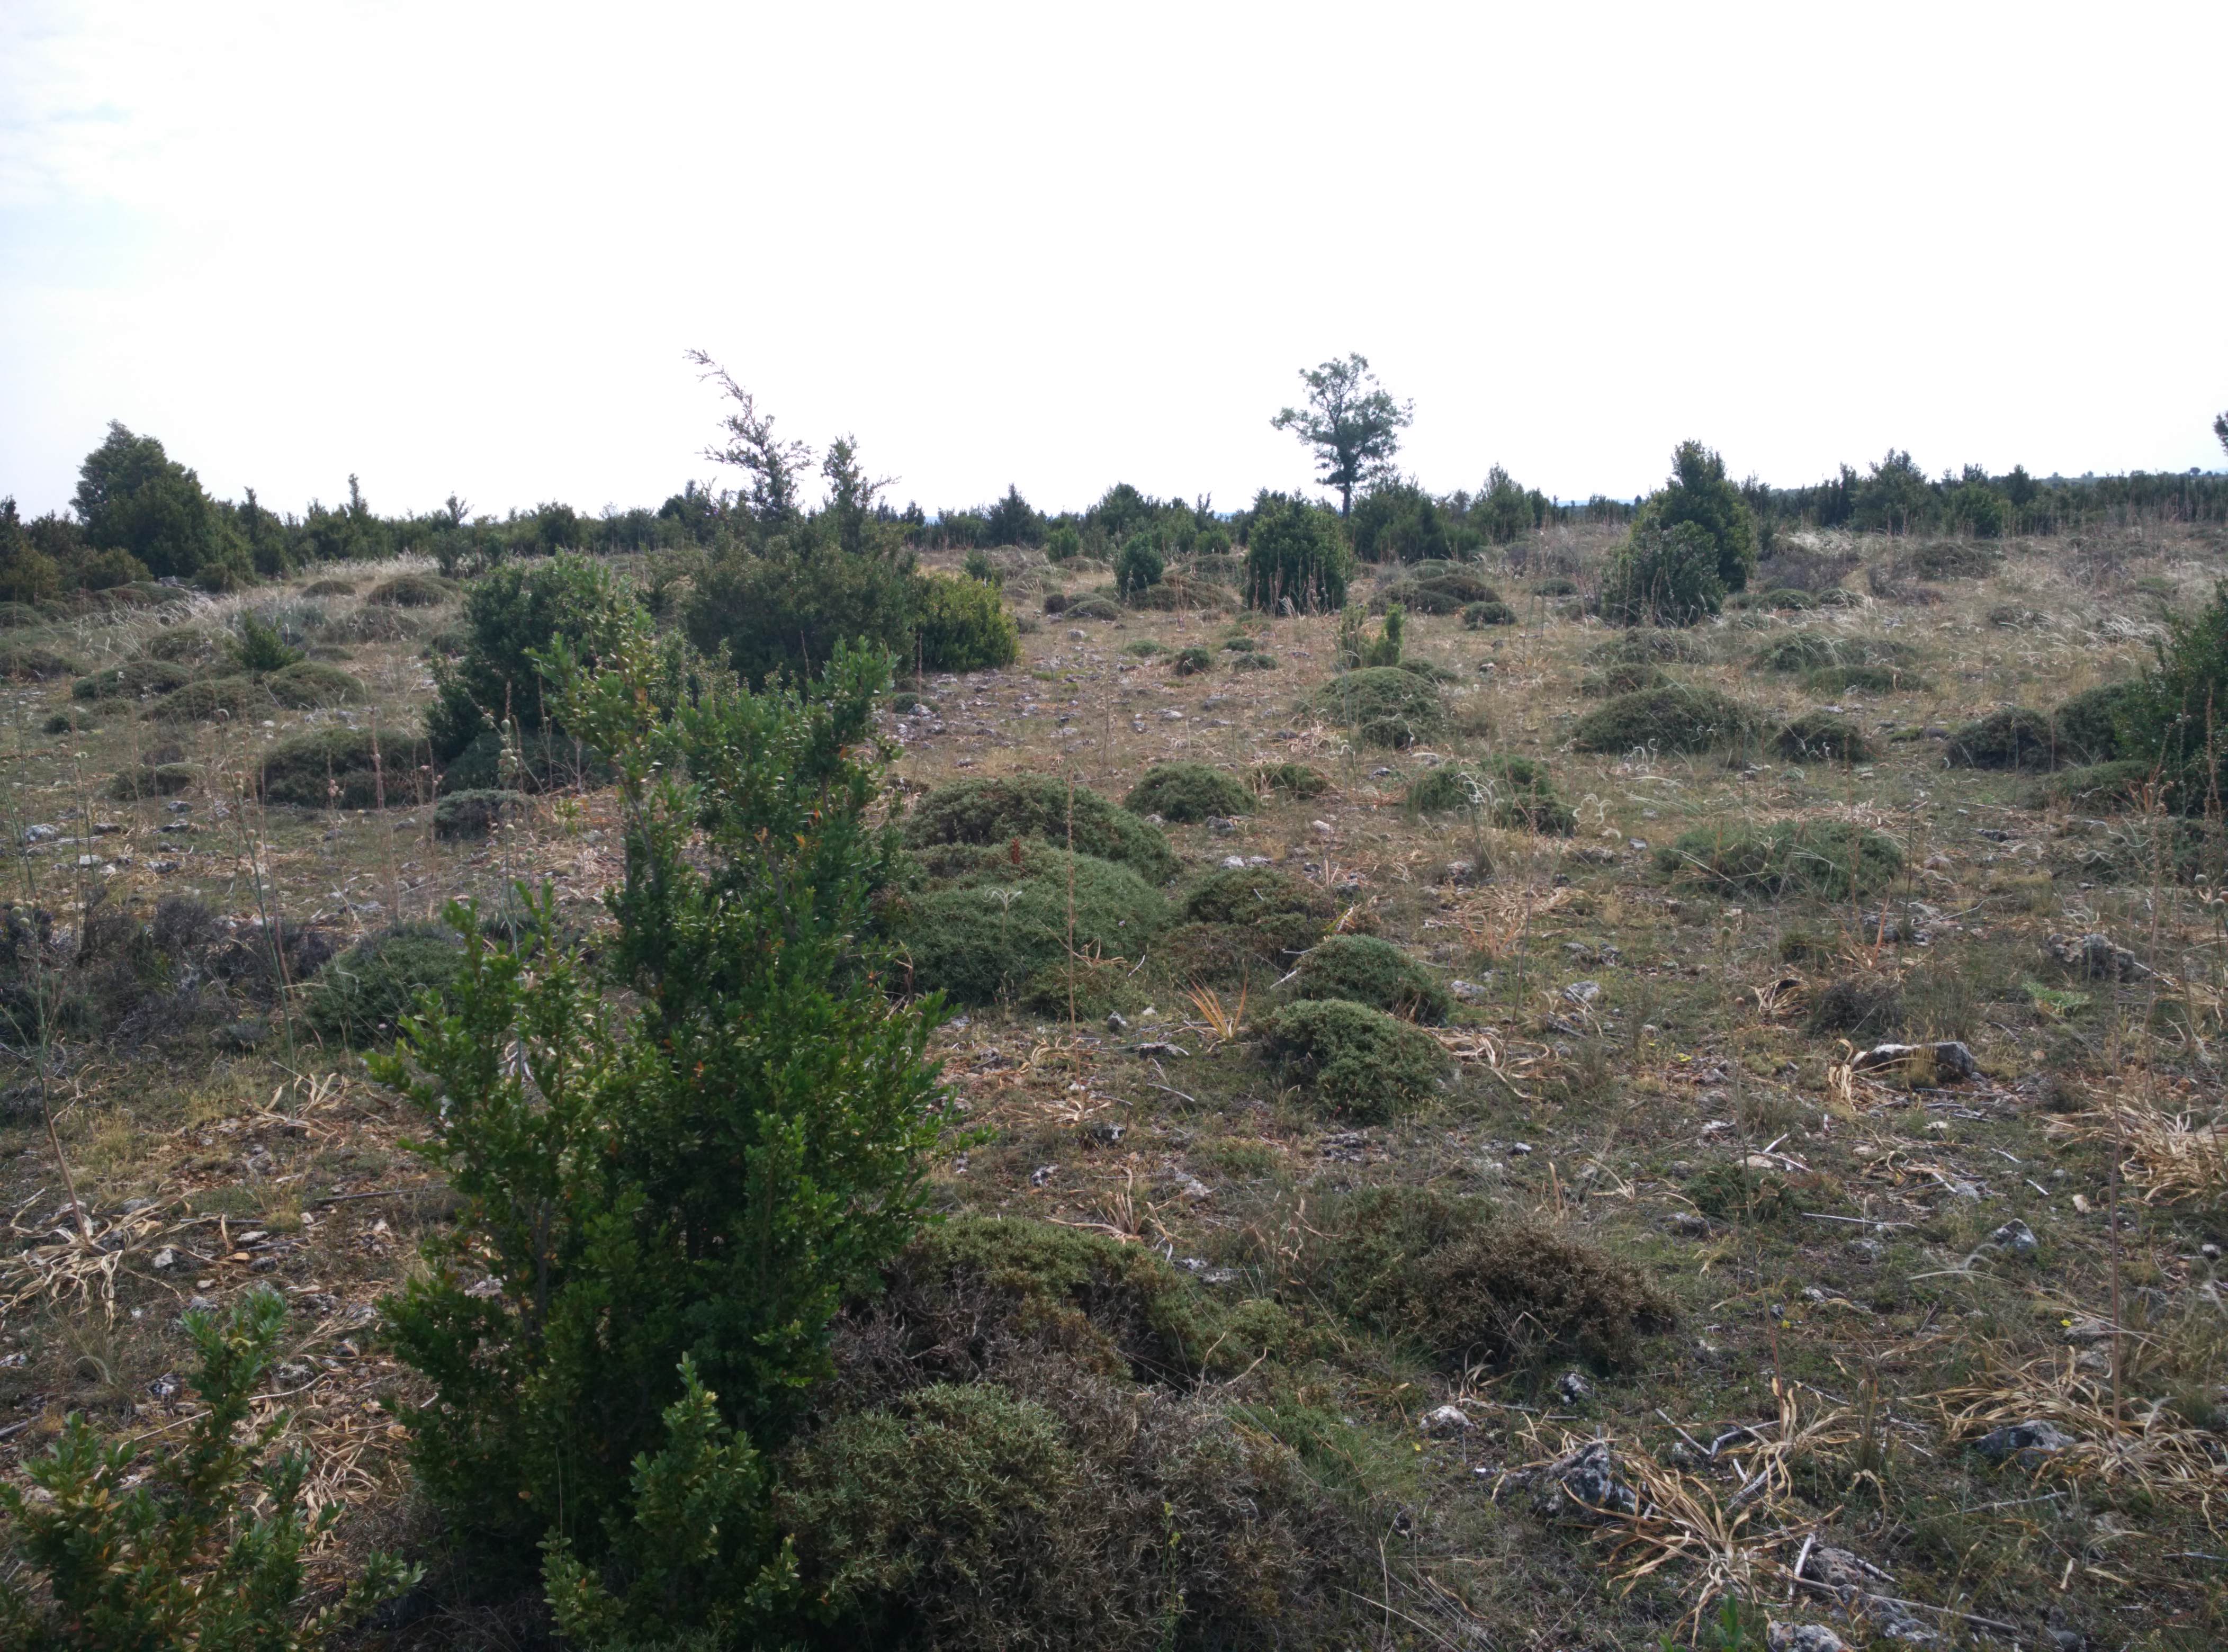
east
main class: Shrubland
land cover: Shrubland without tree cover
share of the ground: 50 - 75 %
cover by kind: shrubs 60 %, unconsolidated bare surface 35 %, herbaceous plants 5 %
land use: Semi-natural and natural areas not in use
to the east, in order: Shrubland without tree cover; Tracks; Shrubland without tree cover; Rock outcrops; Shrubland without tree cover
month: June
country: ES
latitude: 40.6986
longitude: -1.9865
